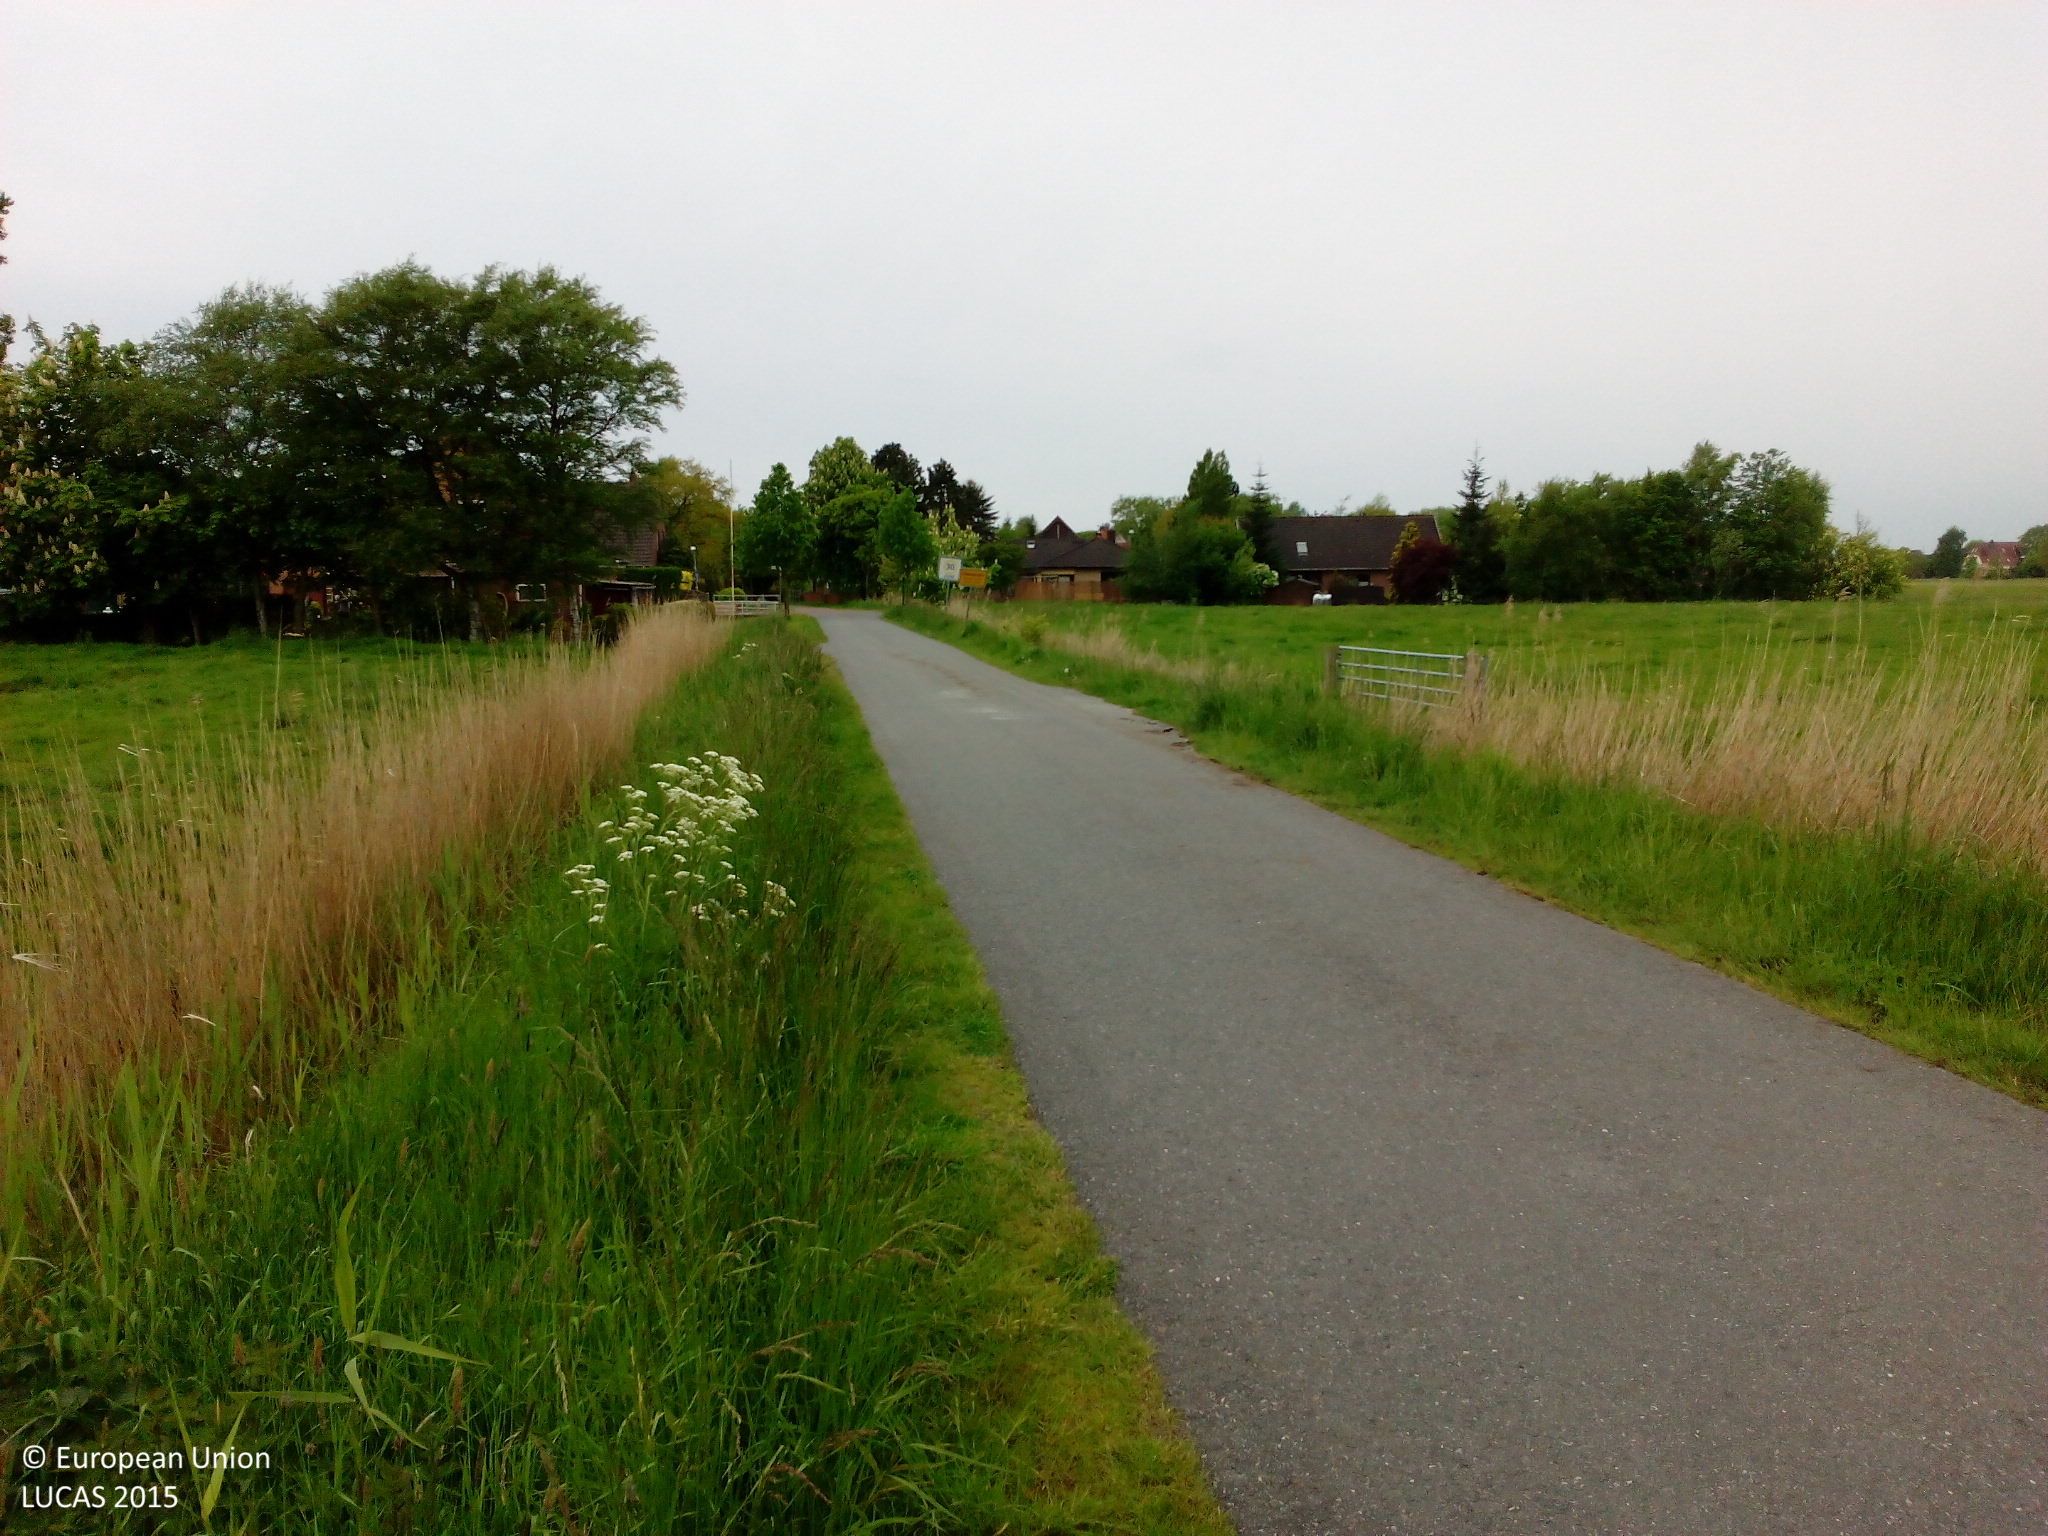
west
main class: Grassland
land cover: Grassland without tree/shrub cover
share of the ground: > 75 %
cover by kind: herbaceous plants 100 %
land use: Agriculture (excluding fallow land and kitchen gardens)
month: May
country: DE
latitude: 53.4467
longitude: 8.5100
